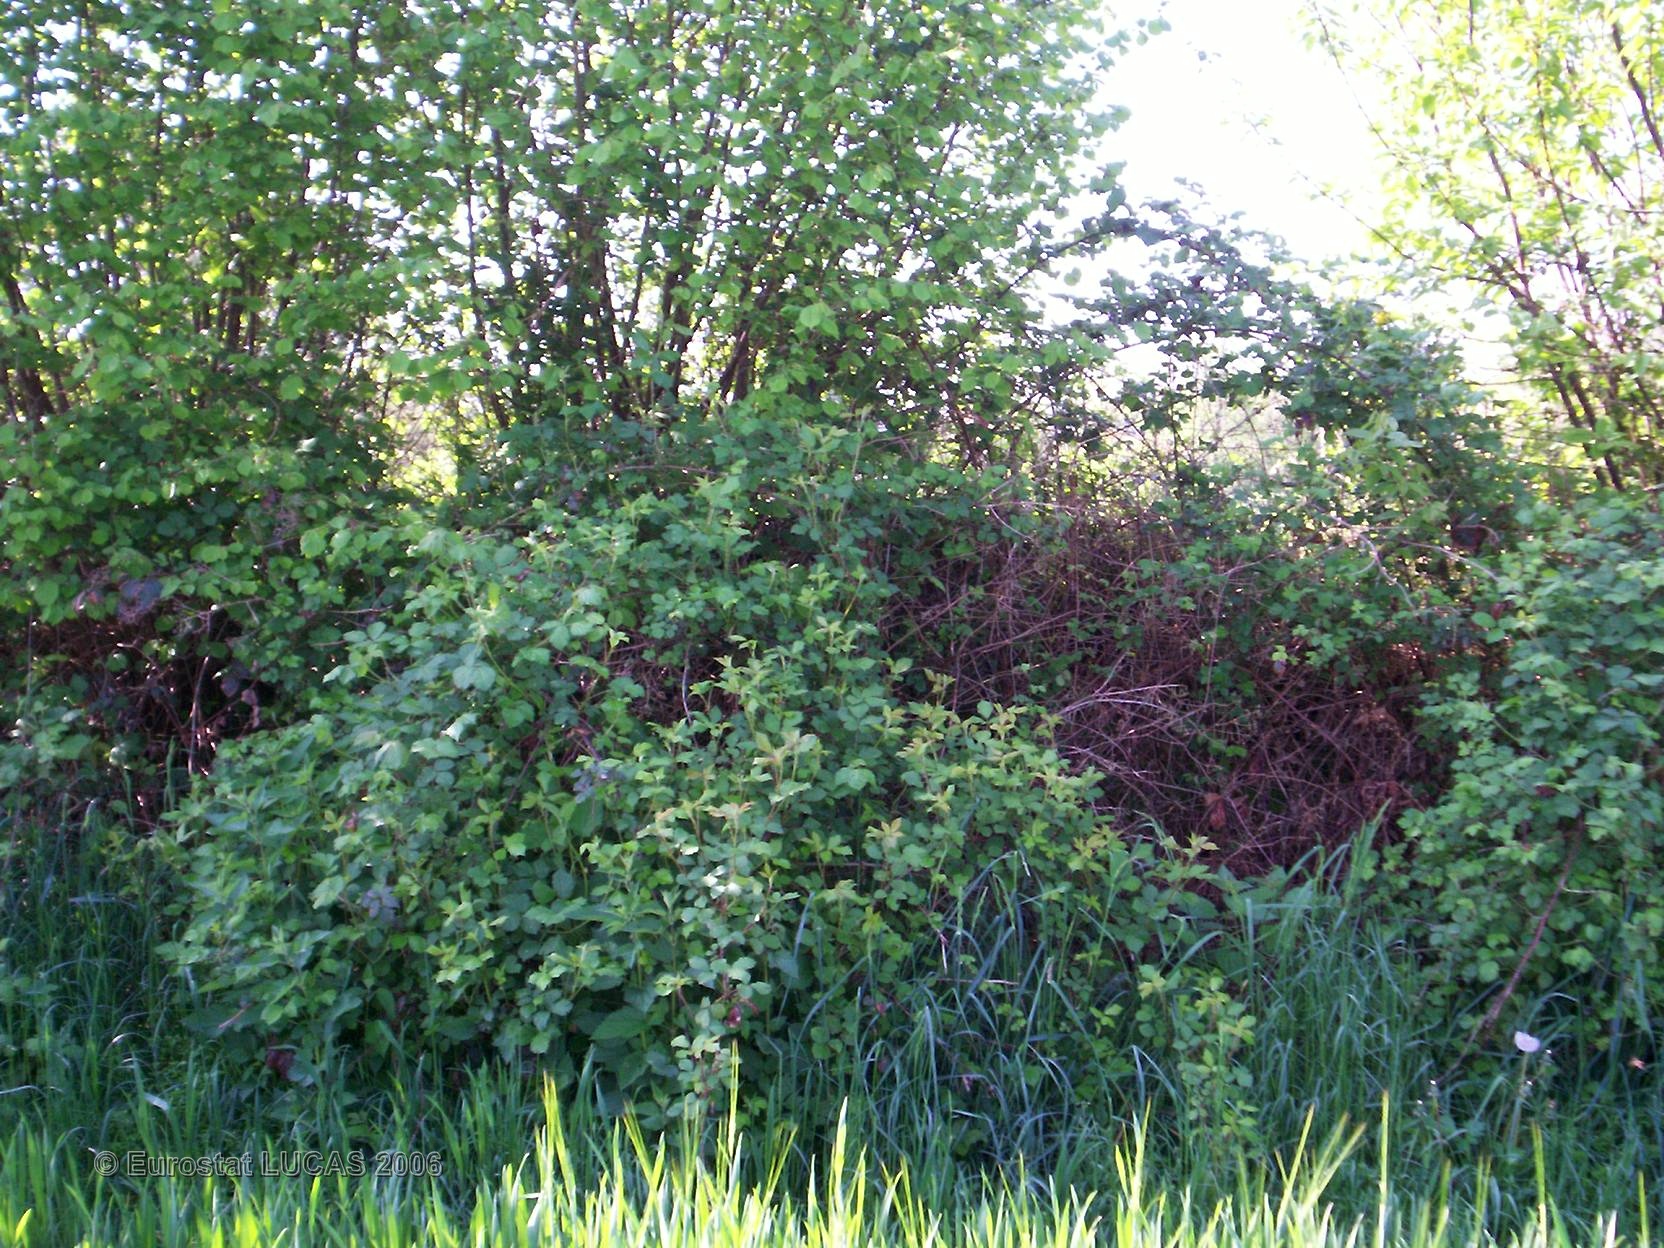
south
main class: Cropland
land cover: Common wheat
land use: Agriculture (excluding fallow land and kitchen gardens)
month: May
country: FR
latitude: 48.2686
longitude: -1.3750
